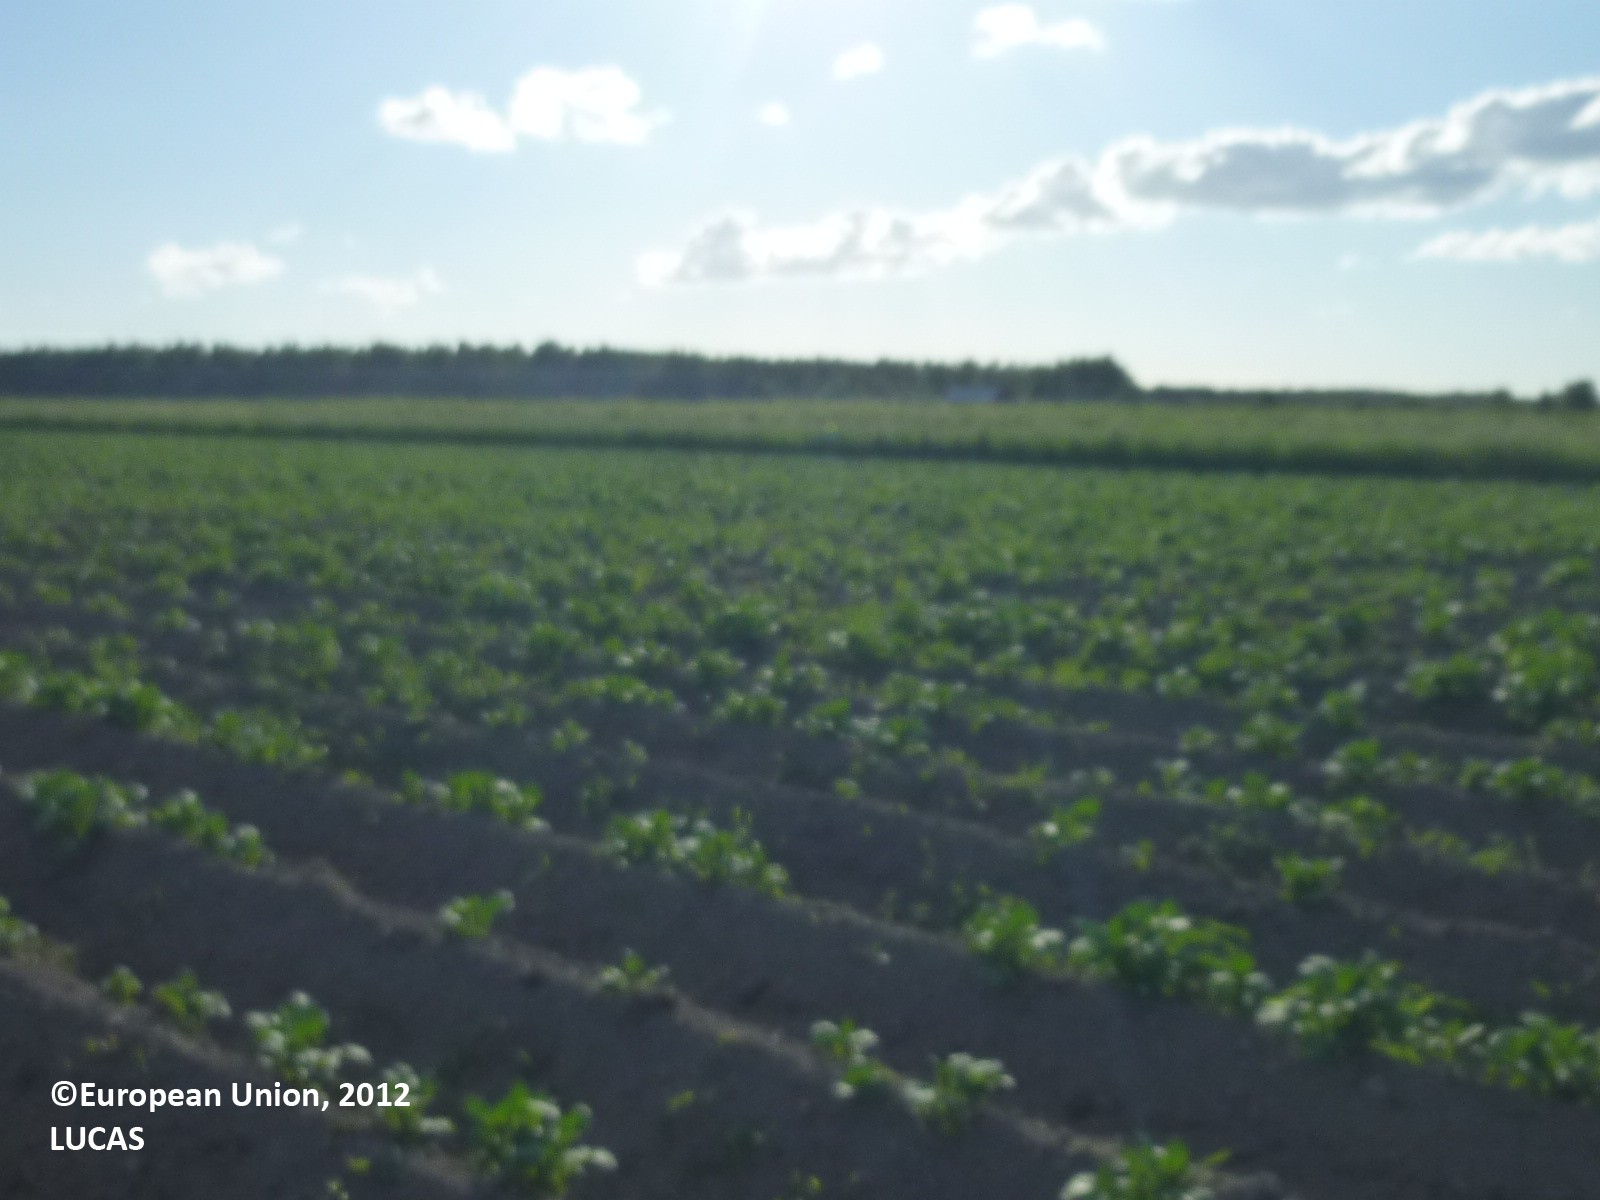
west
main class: Cropland
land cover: Potatoes
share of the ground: 10 - 25 %
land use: Agriculture (excluding fallow land and kitchen gardens)
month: July
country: FI
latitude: 61.2065
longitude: 22.5548
